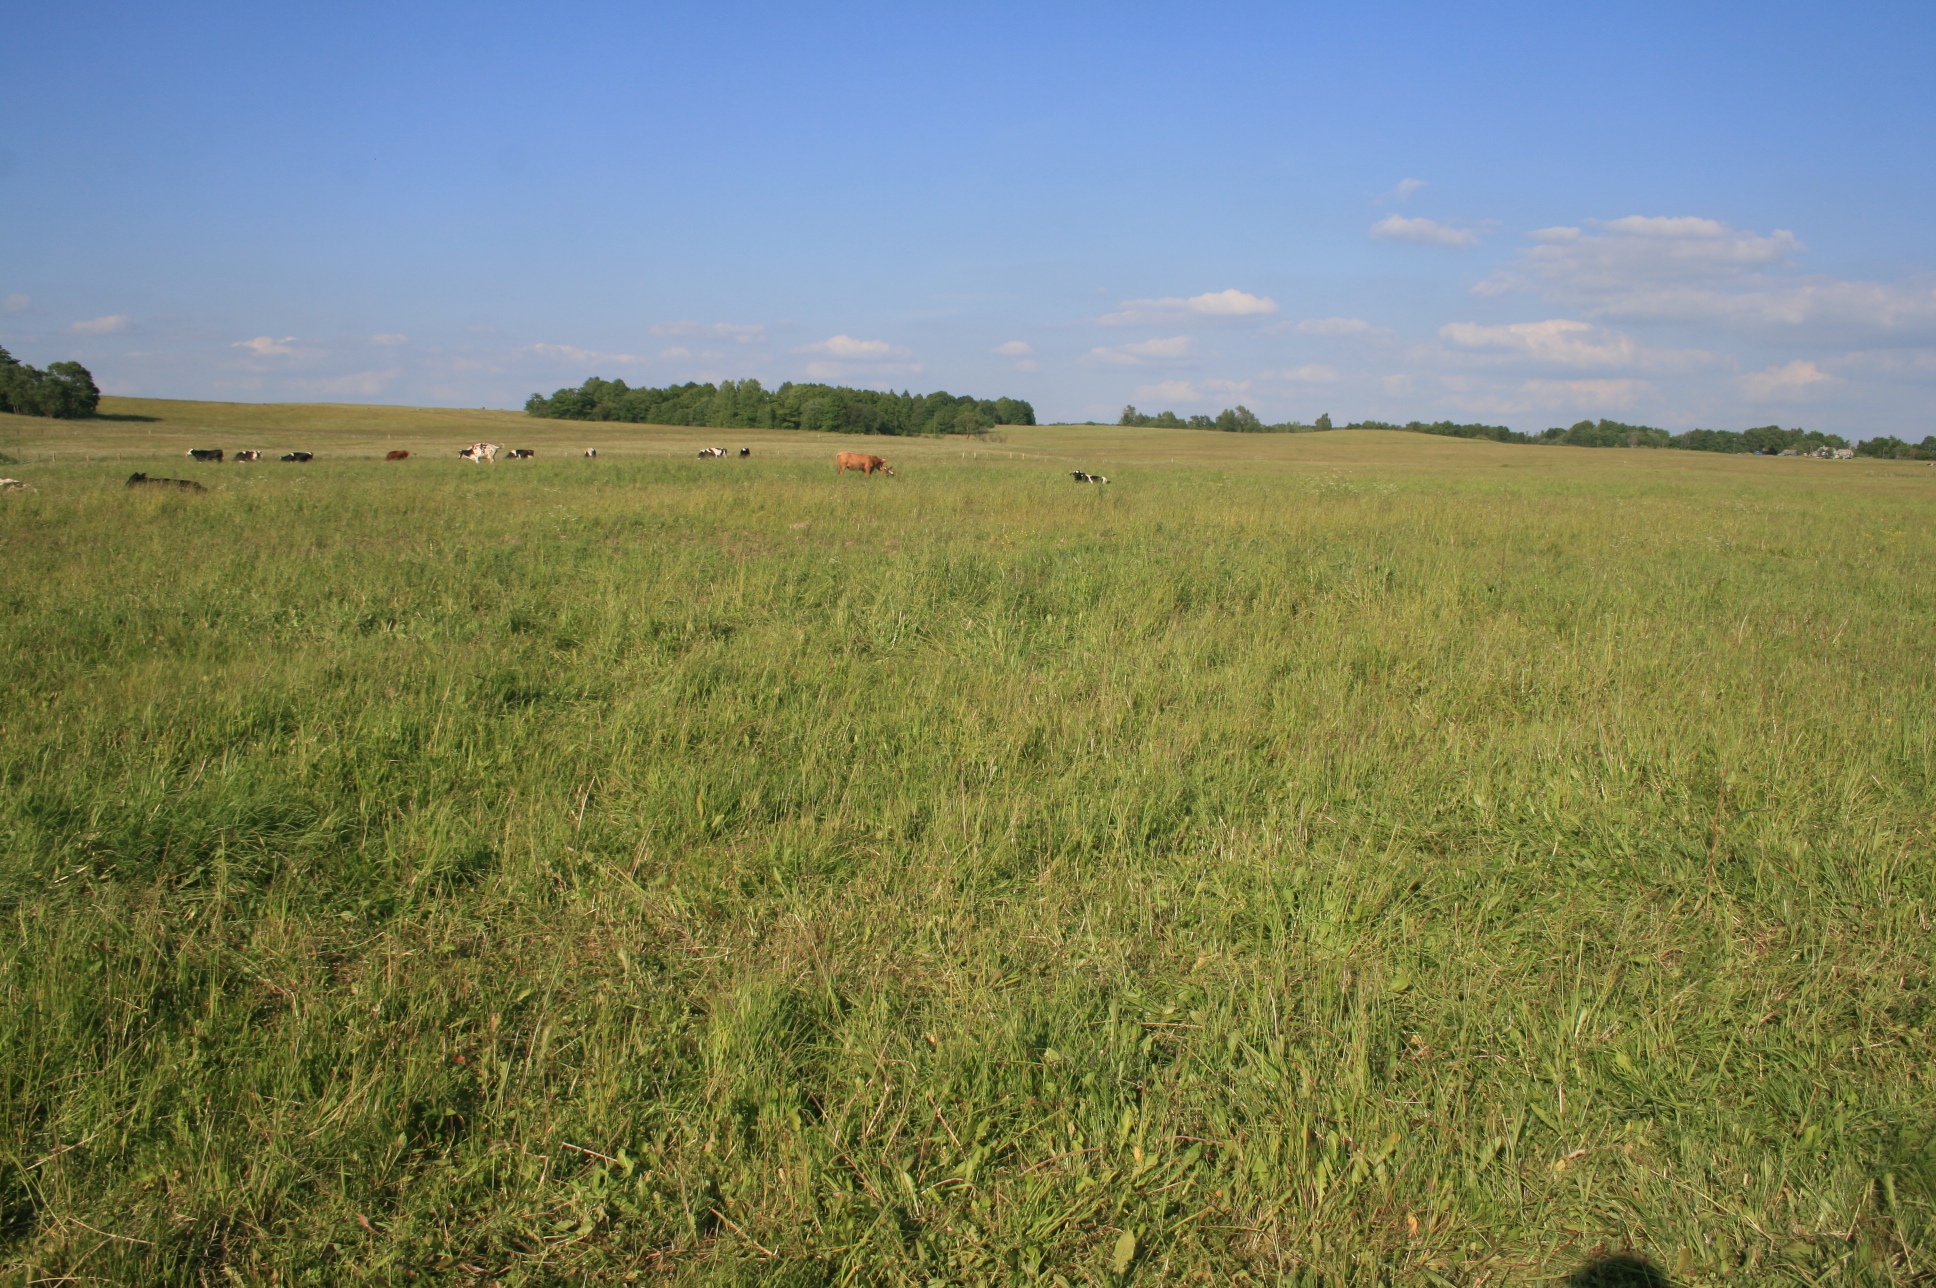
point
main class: Grassland
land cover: Grassland without tree/shrub cover
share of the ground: > 75 %
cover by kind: herbaceous plants 100 %
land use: Agriculture (excluding fallow land and kitchen gardens)
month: June
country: LT
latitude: 55.6562
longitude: 22.2146
